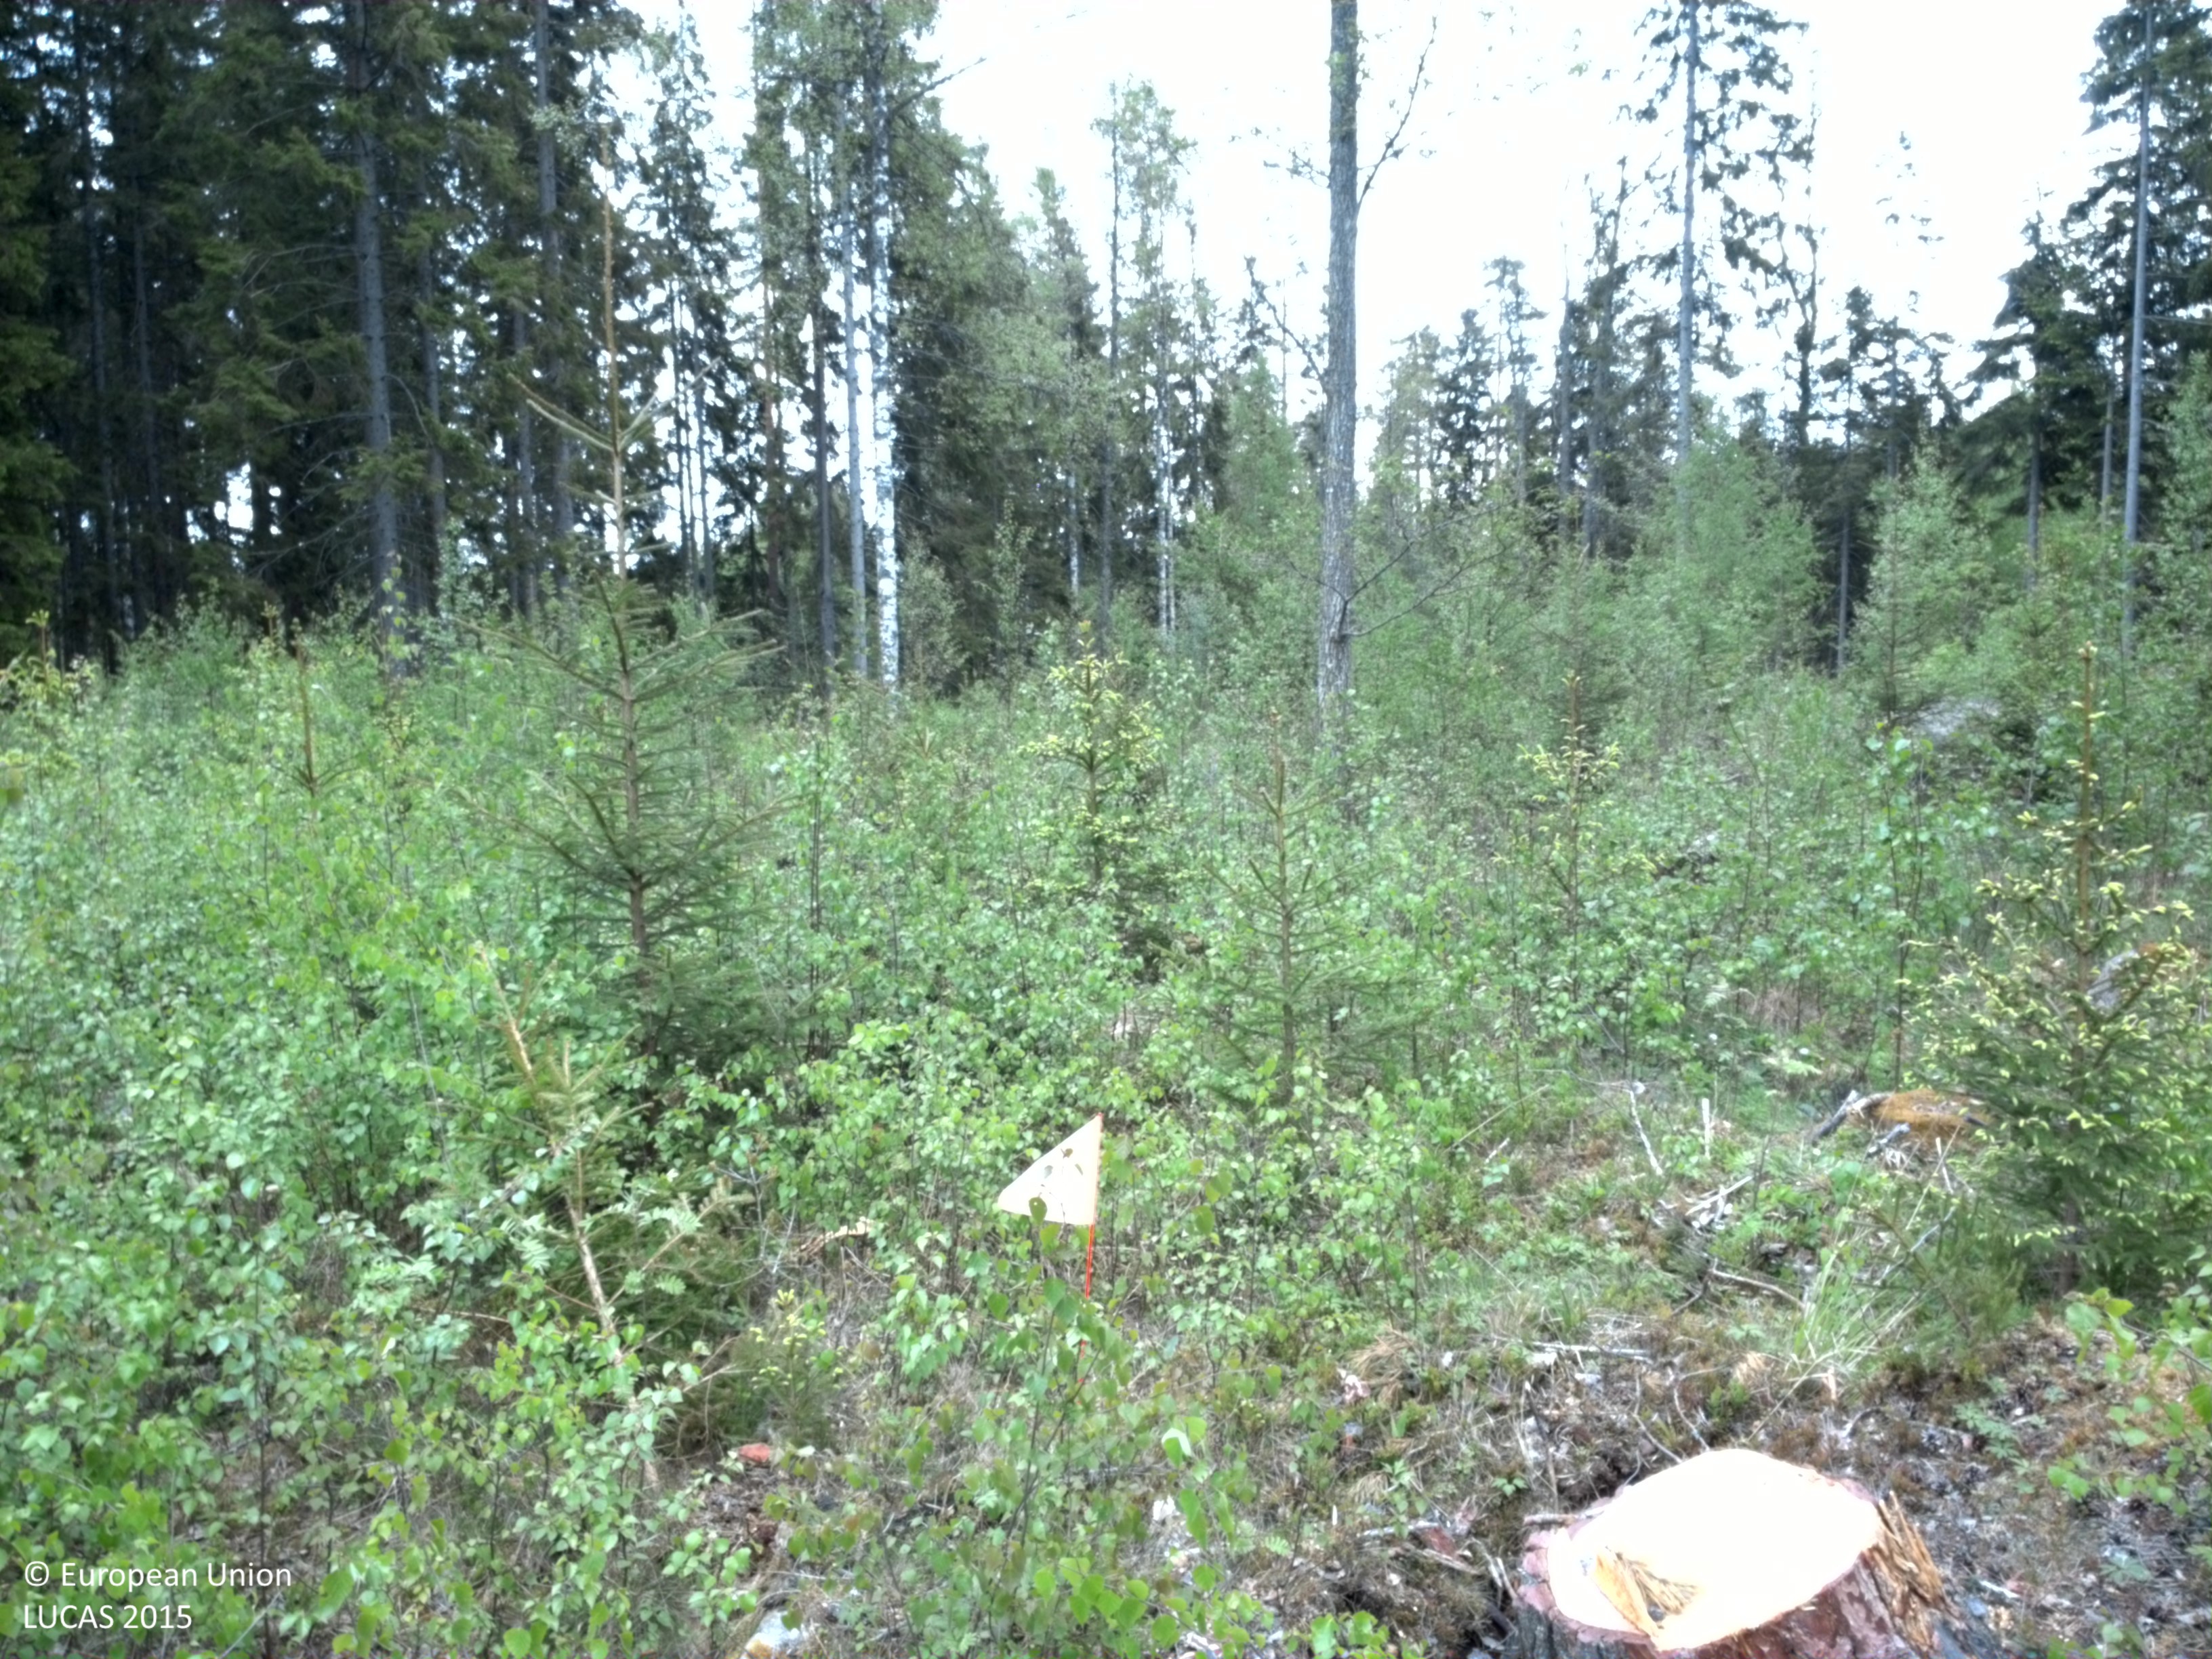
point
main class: Woodland
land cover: Spruce dominated mixed woodland
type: boreal forest
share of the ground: 50 - 75 %
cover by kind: broadleaved forest trees 35 %, coniferous forest trees 25 %, shrubs 15 %, herbaceous plants 15 %, lichens and mosses 10 %
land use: Forestry
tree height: < 5 m
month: May
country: SE
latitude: 57.3815
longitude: 15.6027
